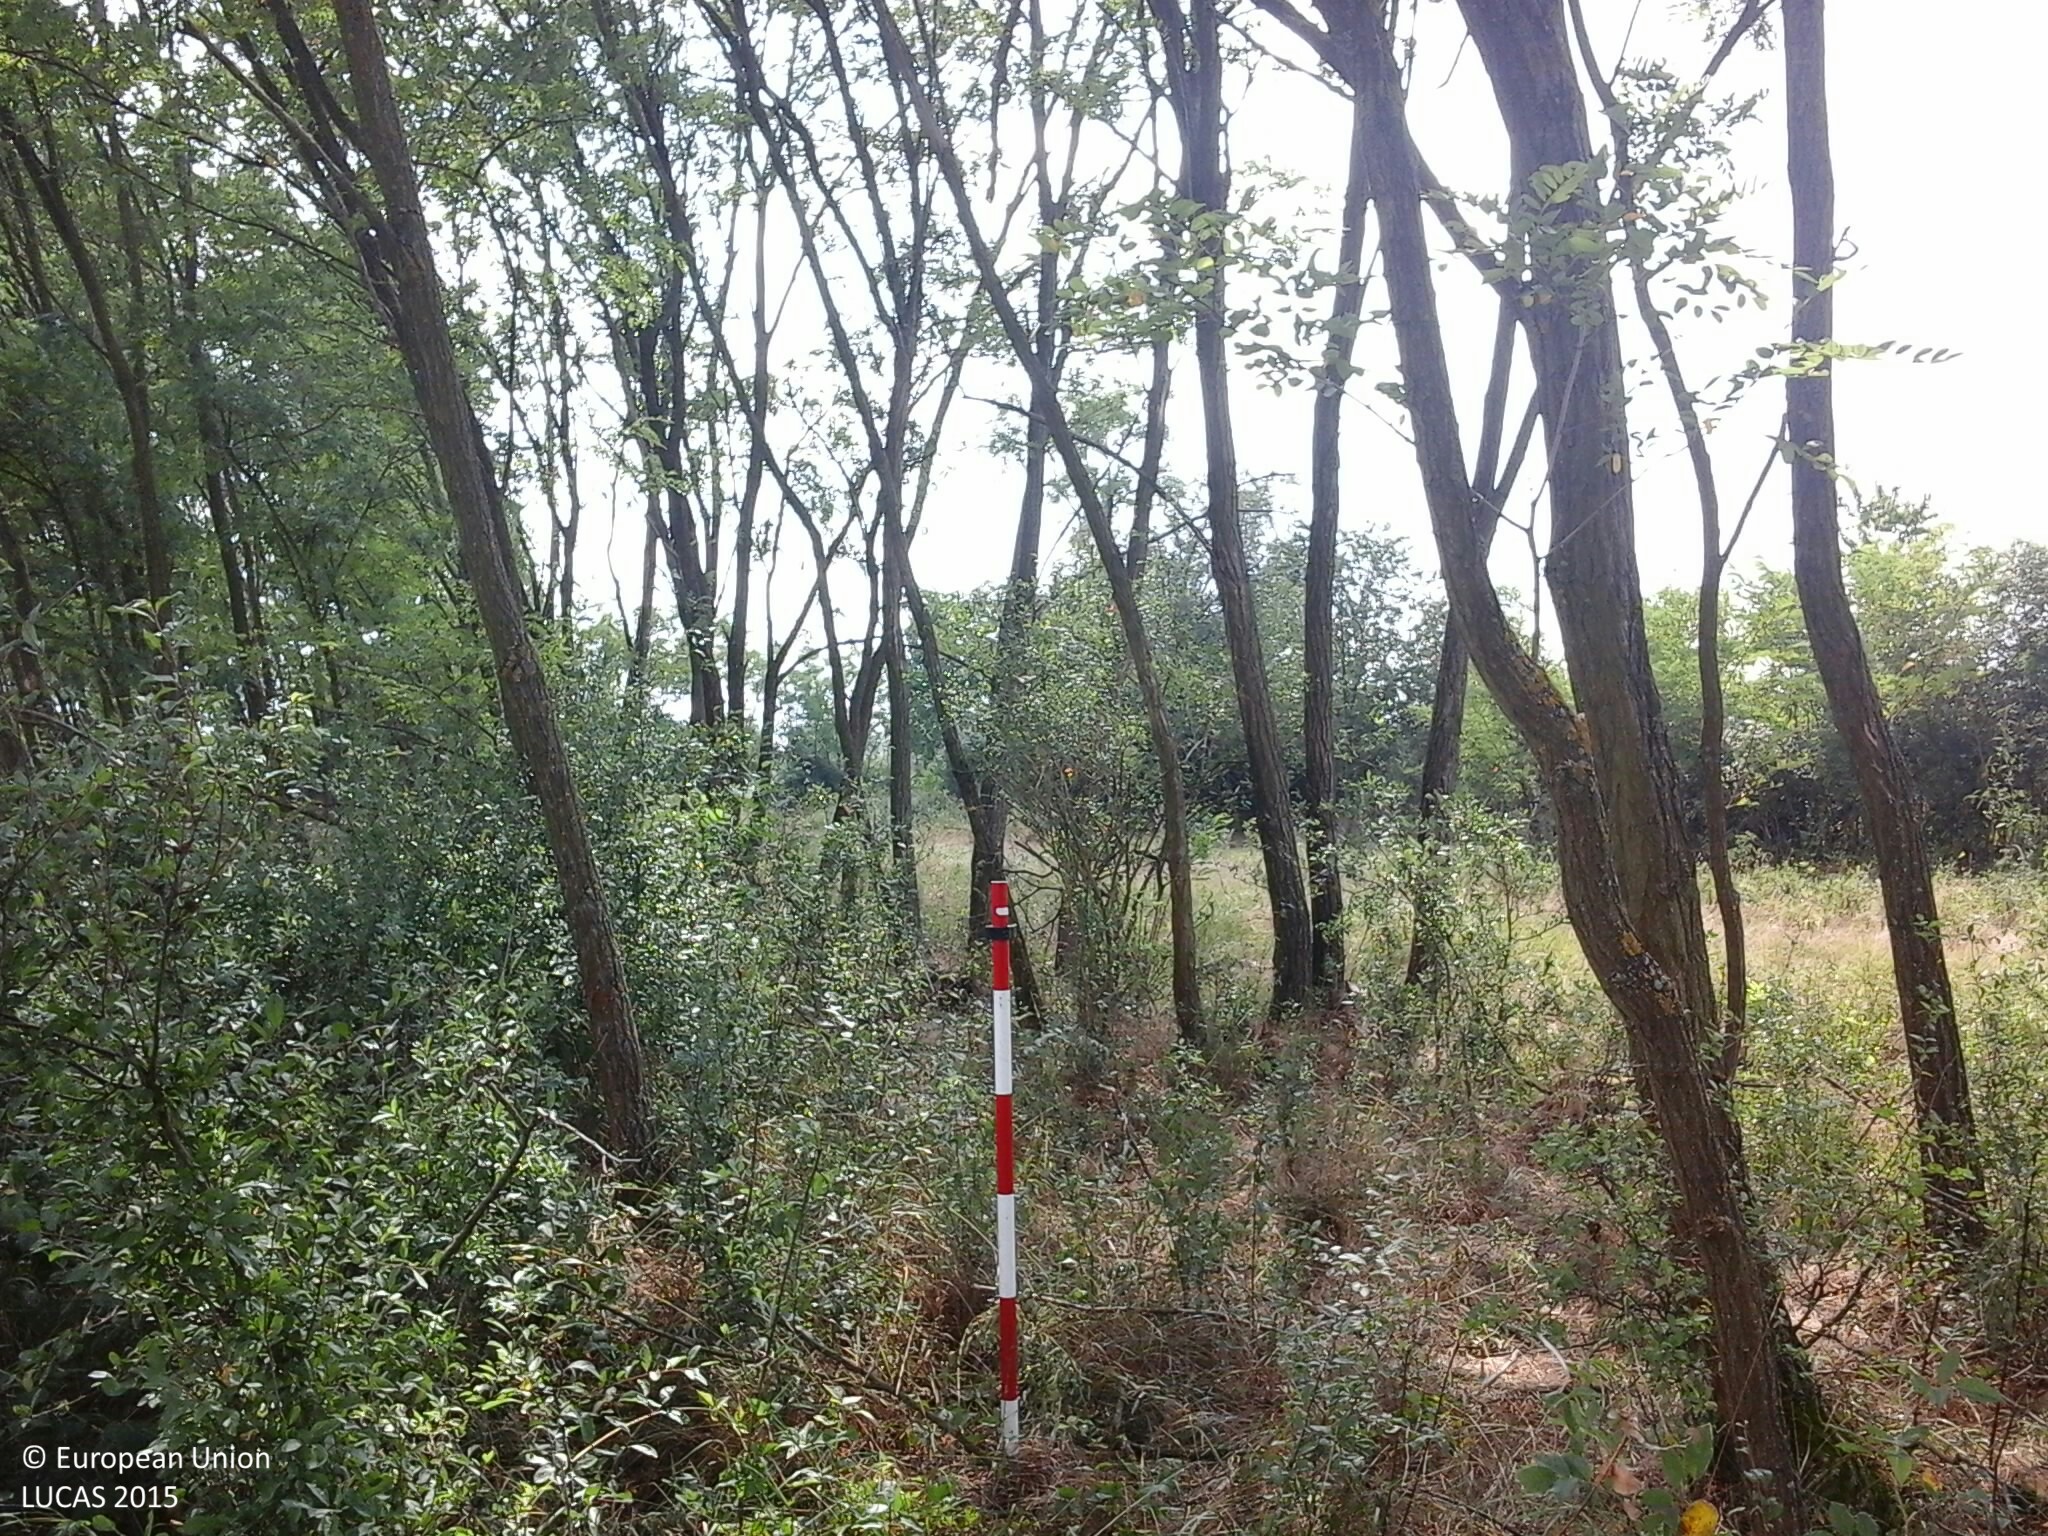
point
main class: Woodland
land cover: Broadleaved woodland
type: exotic forest
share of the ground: > 75 %
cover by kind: broadleaved forest trees 85 %, shrubs 10 %, herbaceous plants 5 %
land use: Forestry
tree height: > 5 m
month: July
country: HU
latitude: 48.2120
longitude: 22.3997
